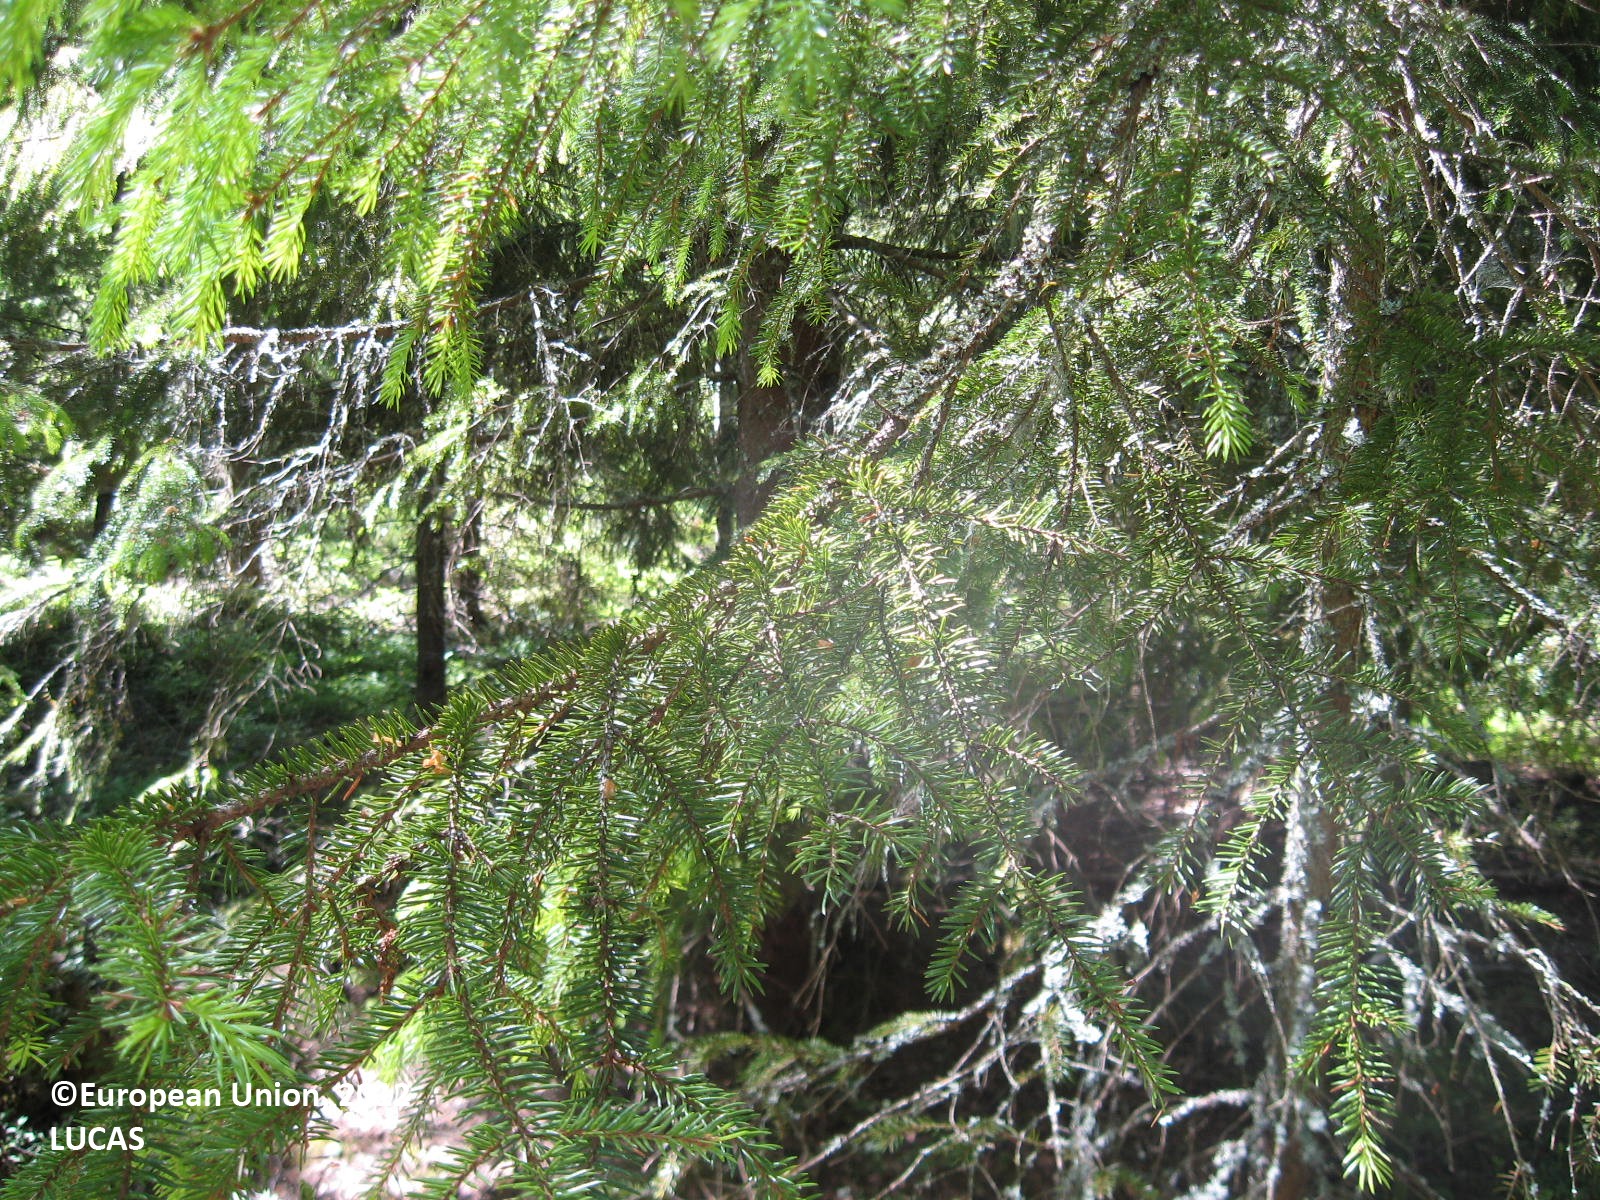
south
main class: Woodland
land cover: Spruce dominated mixed woodland
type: boreal forest
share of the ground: > 75 %
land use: Forestry
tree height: > 5 m
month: June
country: FI
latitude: 62.8049
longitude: 21.3166
